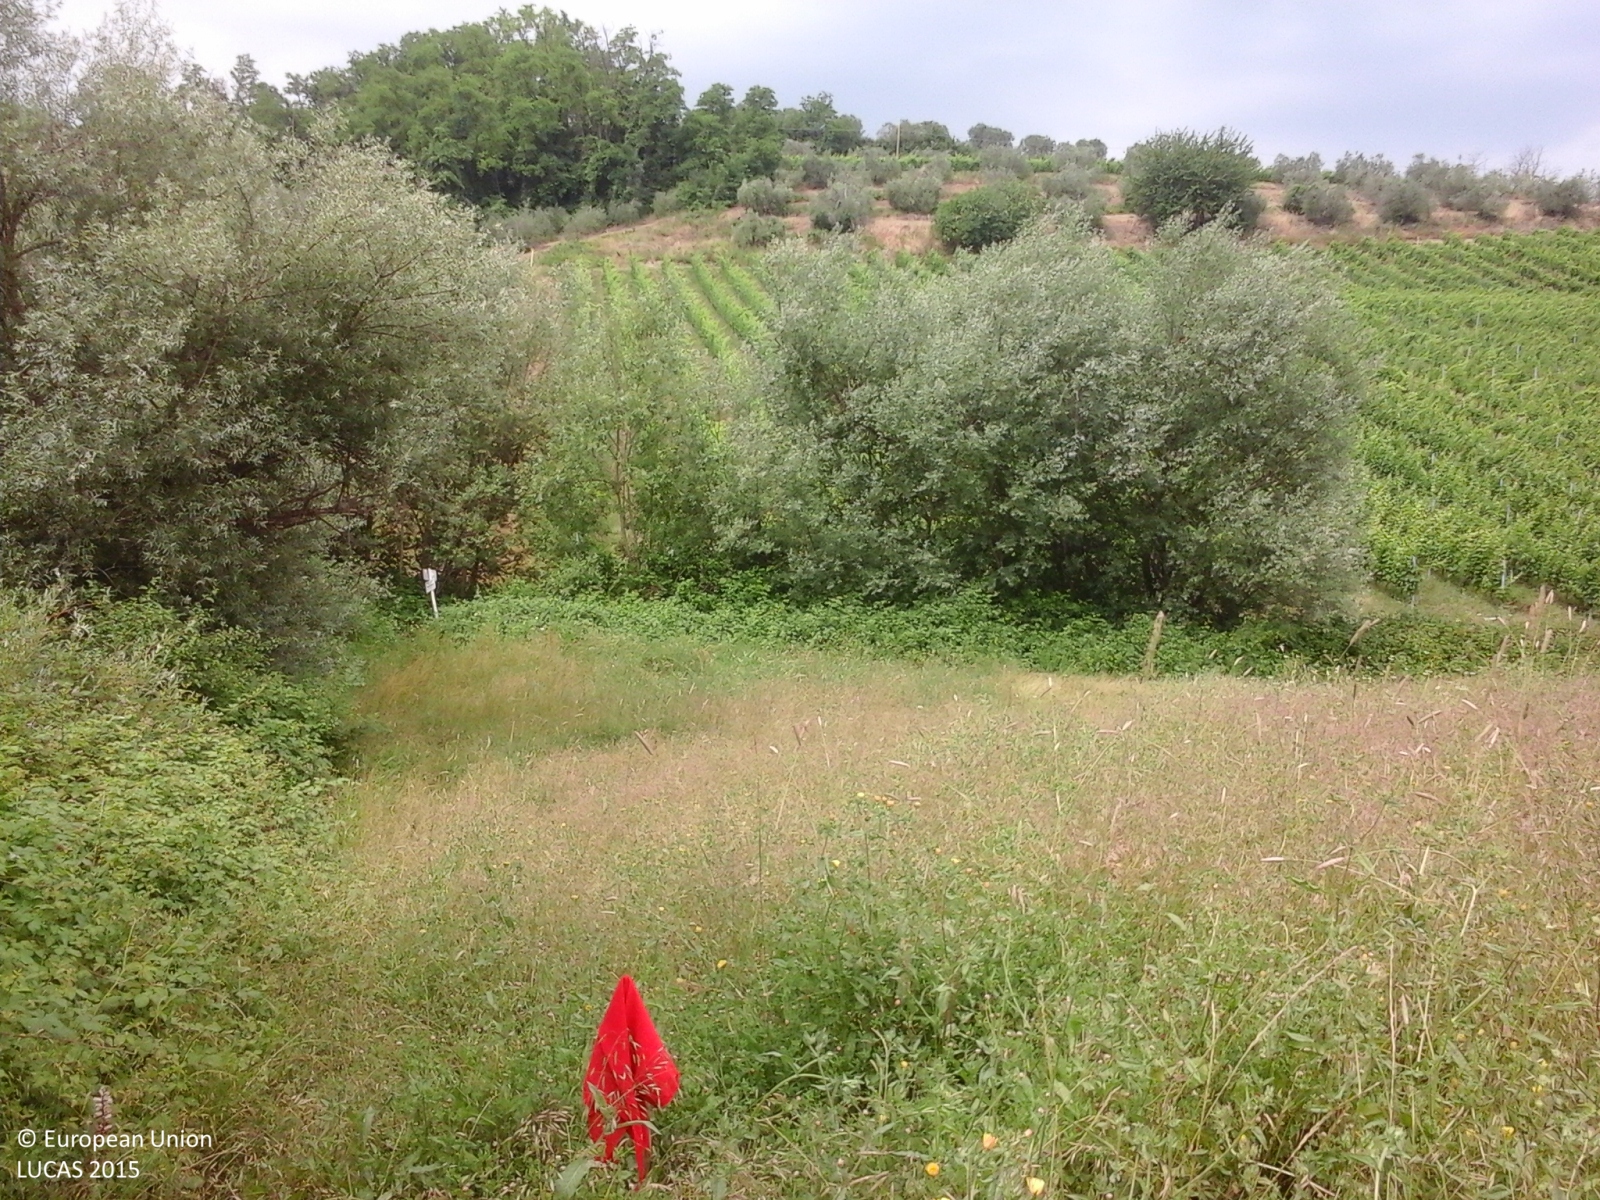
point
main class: Cropland
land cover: Temporary grasslands
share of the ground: > 75 %
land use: Agriculture (excluding fallow land and kitchen gardens)
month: August
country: IT
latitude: 43.6606
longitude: 10.9522
